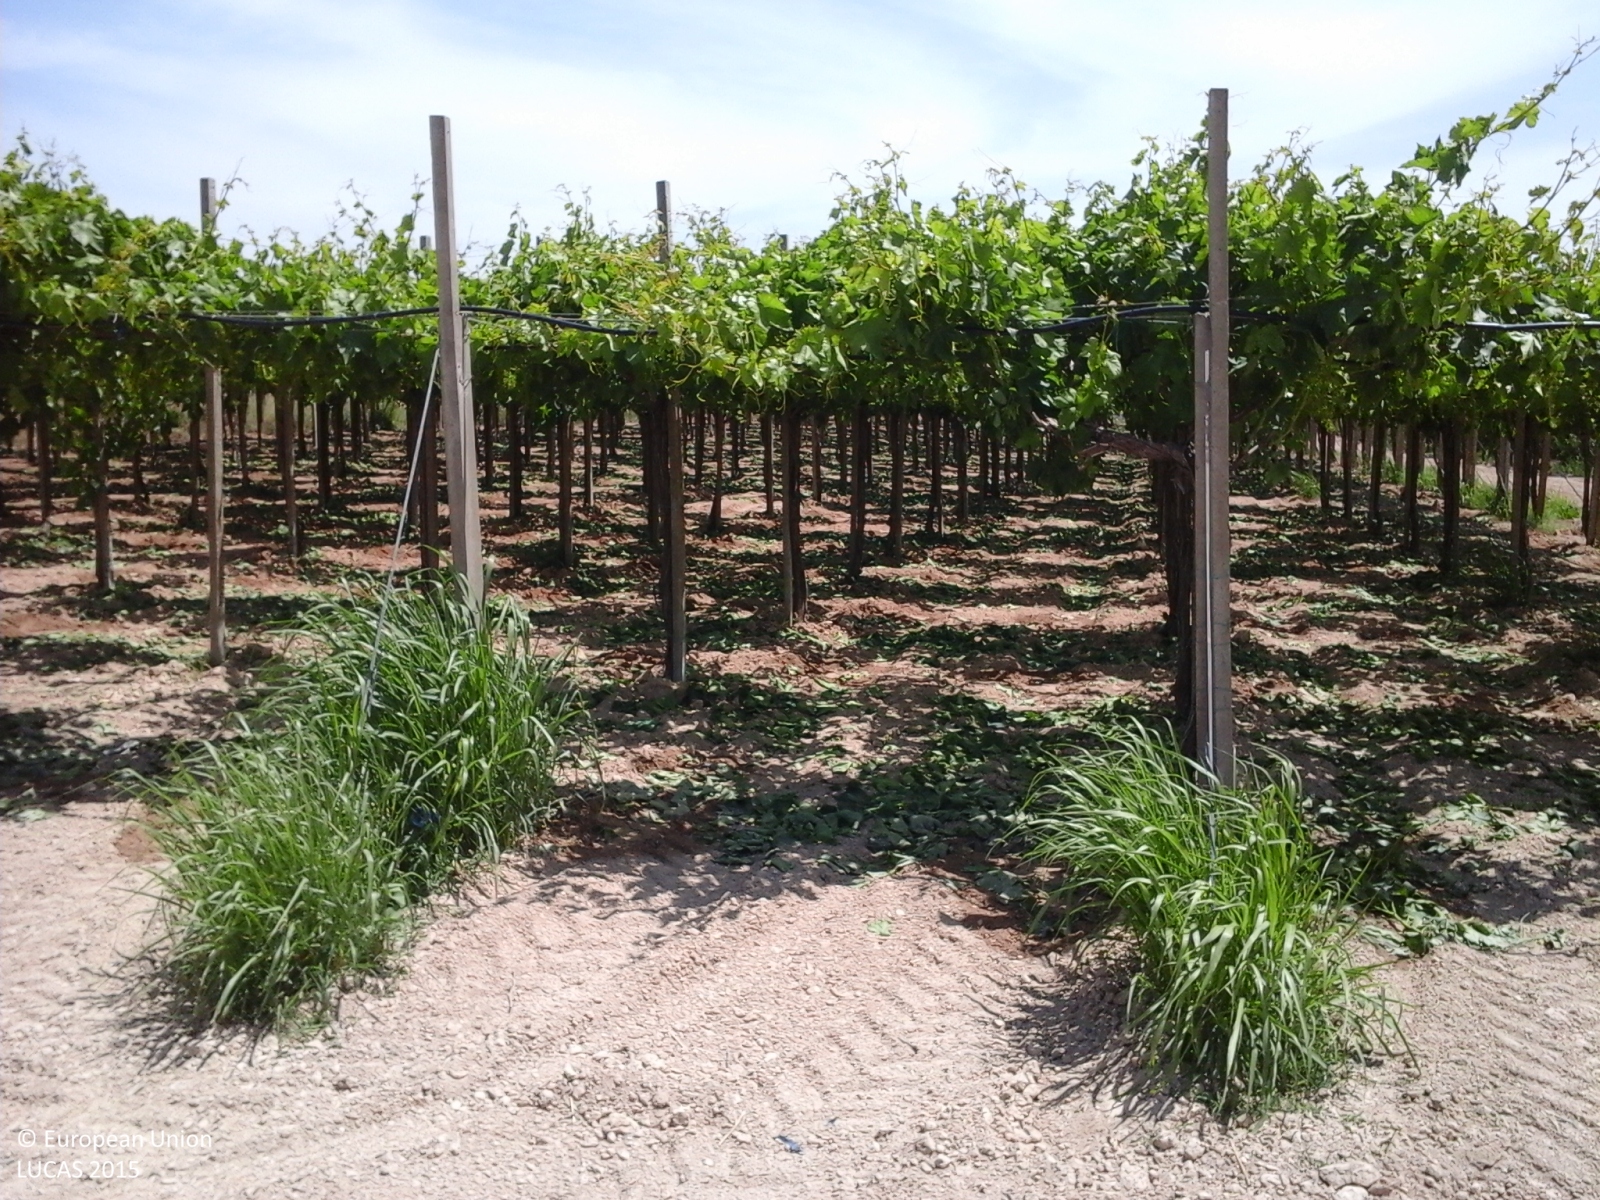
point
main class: Cropland
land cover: Vineyards
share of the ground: 25 - 50 %
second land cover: Spontaneously vegetated surfaces
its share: > 75 %
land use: Agriculture (excluding fallow land and kitchen gardens)
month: May
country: IT
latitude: 37.1104
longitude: 14.5671
